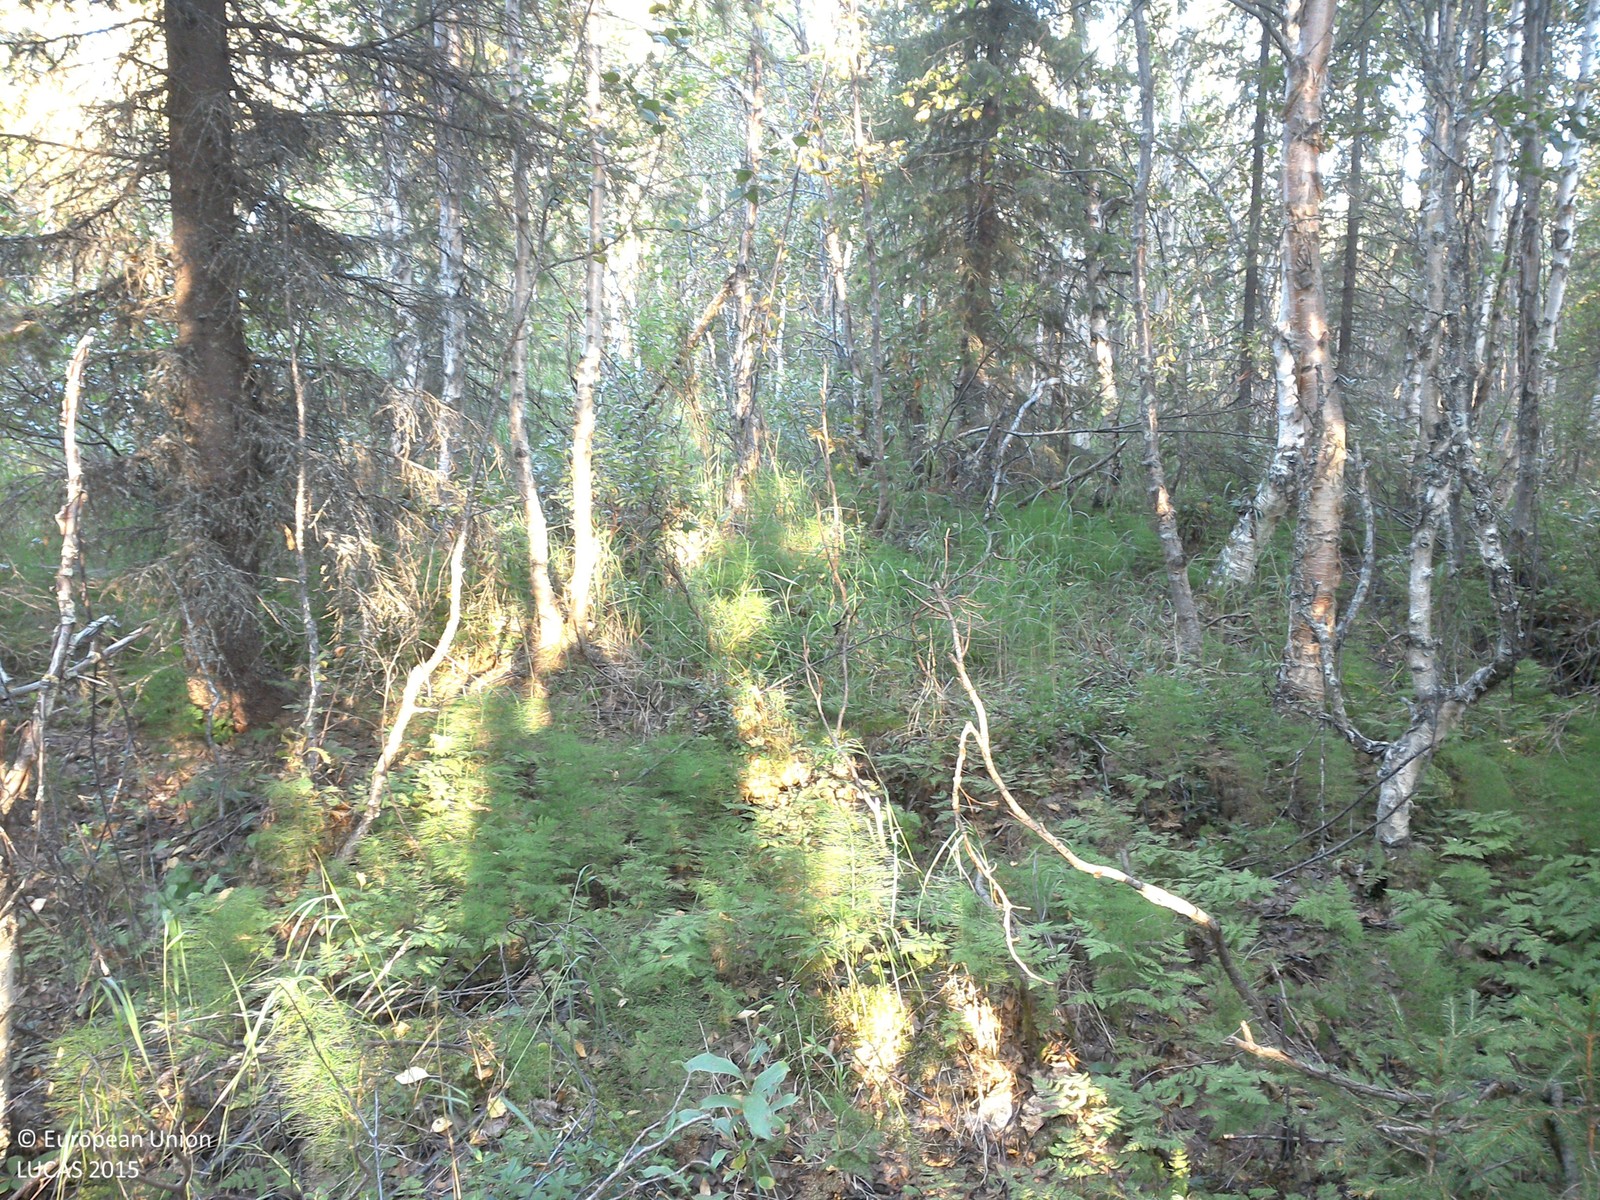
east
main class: Woodland
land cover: Other mixed woodland
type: boreal forest
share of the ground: 25 - 50 %
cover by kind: herbaceous plants 45 %, coniferous forest trees 20 %, broadleaved forest trees 20 %, shrubs 5 %
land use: Forestry
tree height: > 5 m
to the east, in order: Other mixed woodland; Spruce dominated mixed woodland; Ditches and canals; Broadleaved woodland; Ditches and canals; Grassland without tree/shrub cover; Groves; Ditches and canals; Grass margins; Paved roads, cycling and walking lanes; Grass margins; Ditches and canals; Groves; Broadleaved woodland; Grassland with sparse tree/shrub cover; Ditches and canals; Grassland with sparse tree/shrub cover; Broadleaved woodland; Ditches and canals; Shrubland with sparse tree cover; Grassland with sparse tree/shrub cover; Broadleaved woodland; Ditches and canals; Broadleaved woodland
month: August
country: SE
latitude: 67.1286
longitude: 21.7846
